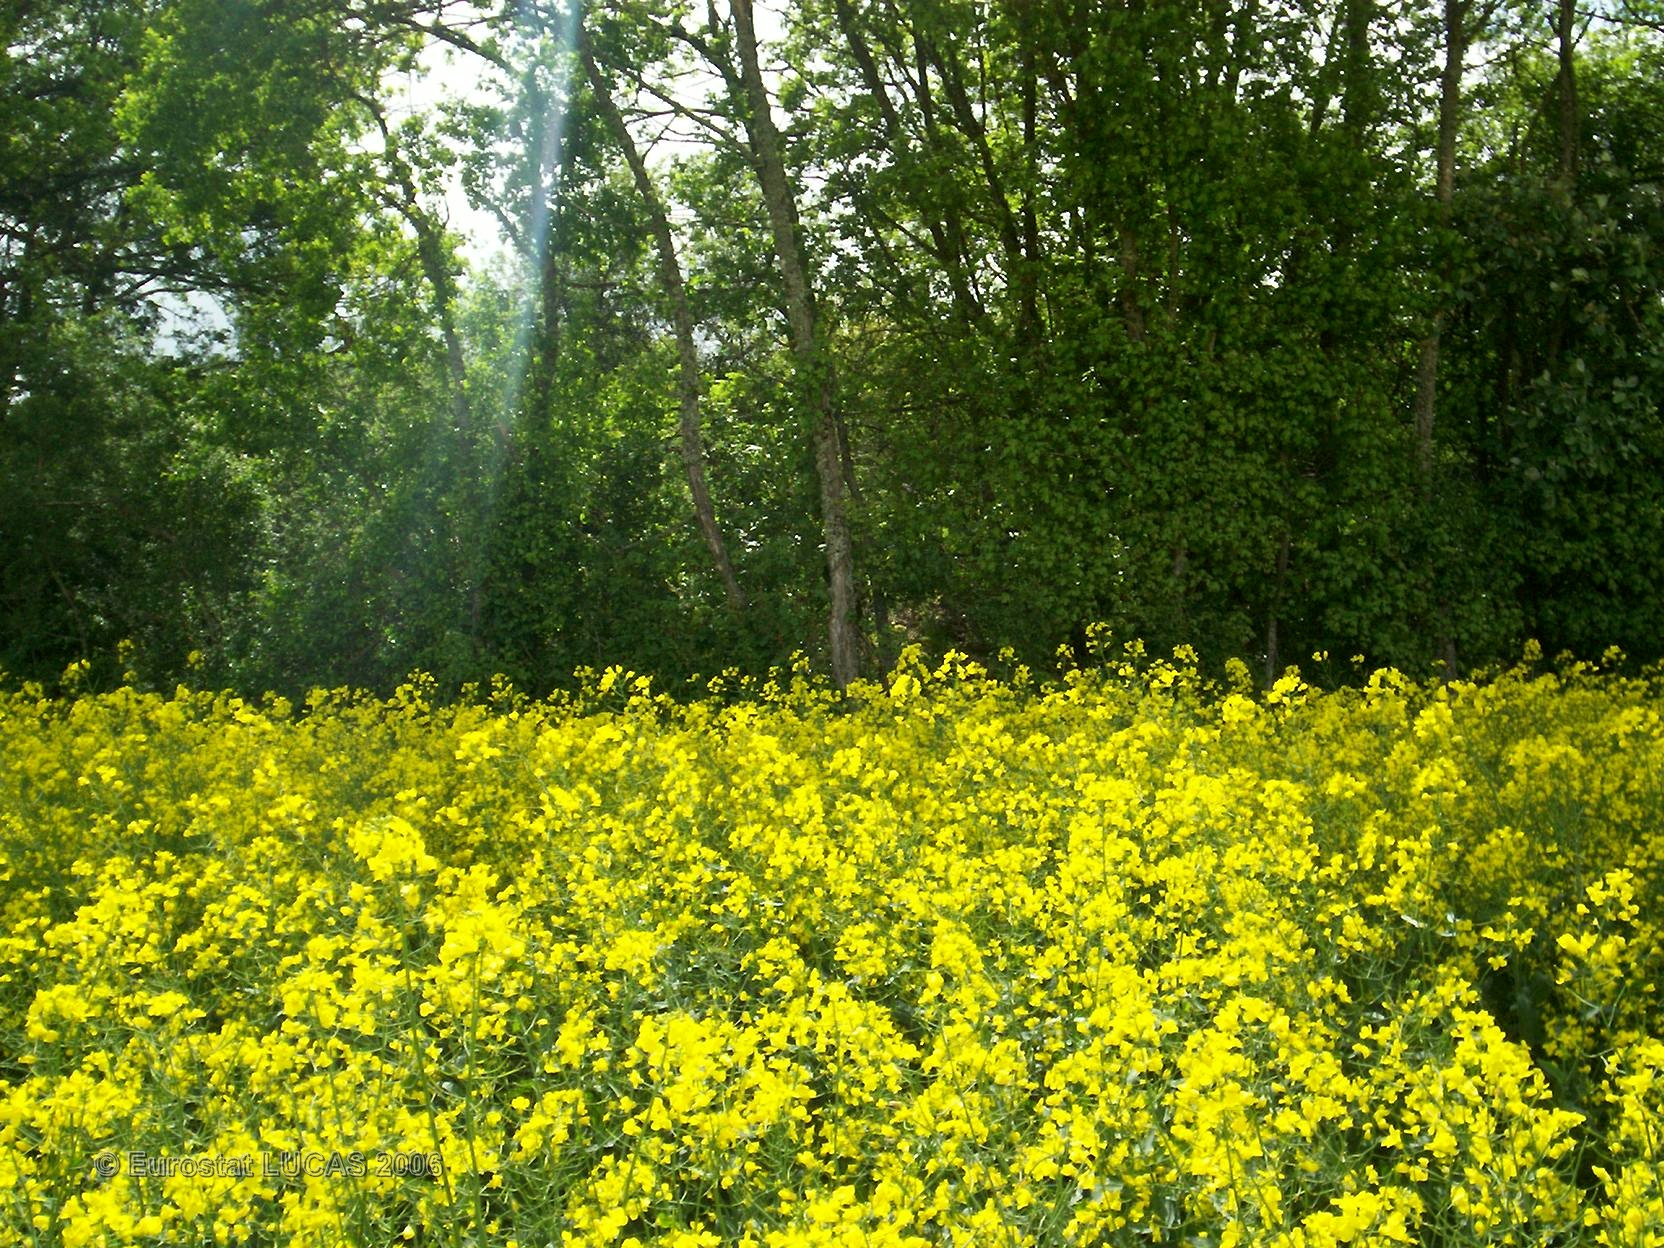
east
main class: Cropland
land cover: Rape and turnip rape
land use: Agriculture (excluding fallow land and kitchen gardens)
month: May
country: FR
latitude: 47.0664
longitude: 4.6676
